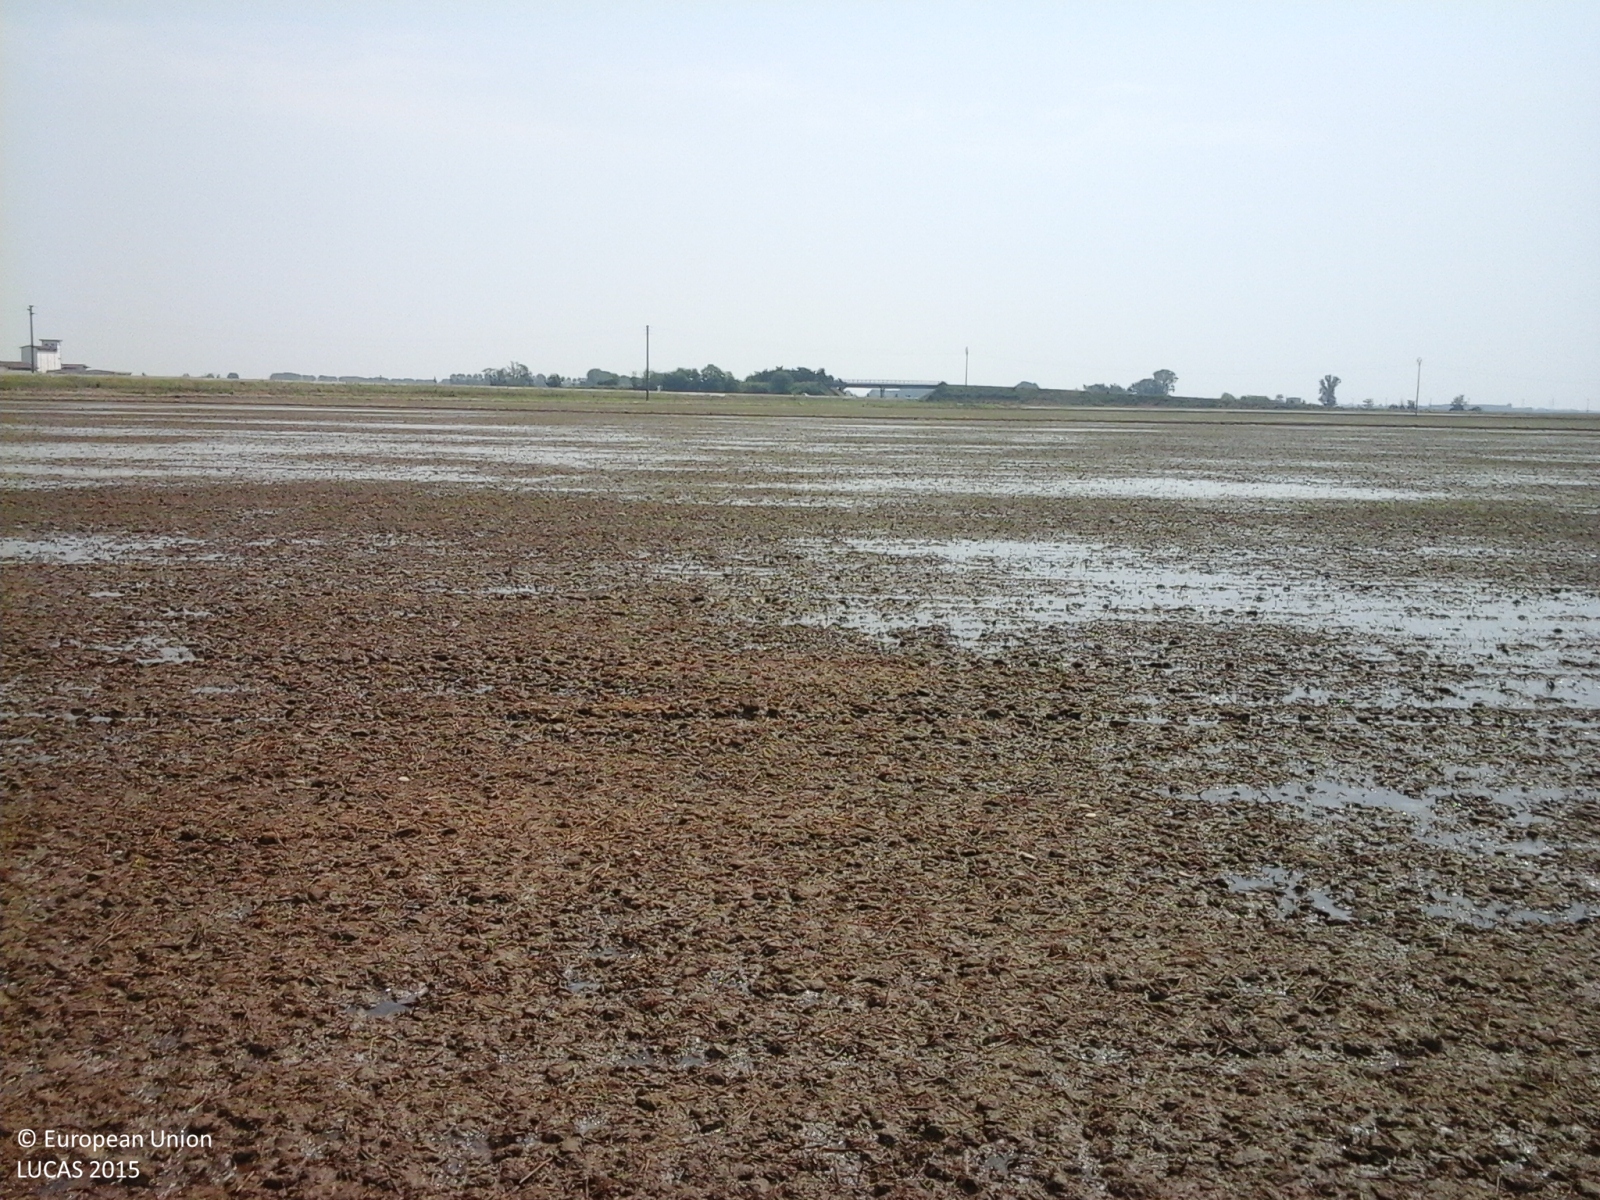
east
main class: Cropland
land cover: Rice
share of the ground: < 10 %
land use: Agriculture (excluding fallow land and kitchen gardens)
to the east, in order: Rice; Grass margins; Rice; Other structural elements; Rice
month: May
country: IT
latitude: 45.3102
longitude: 8.2810
